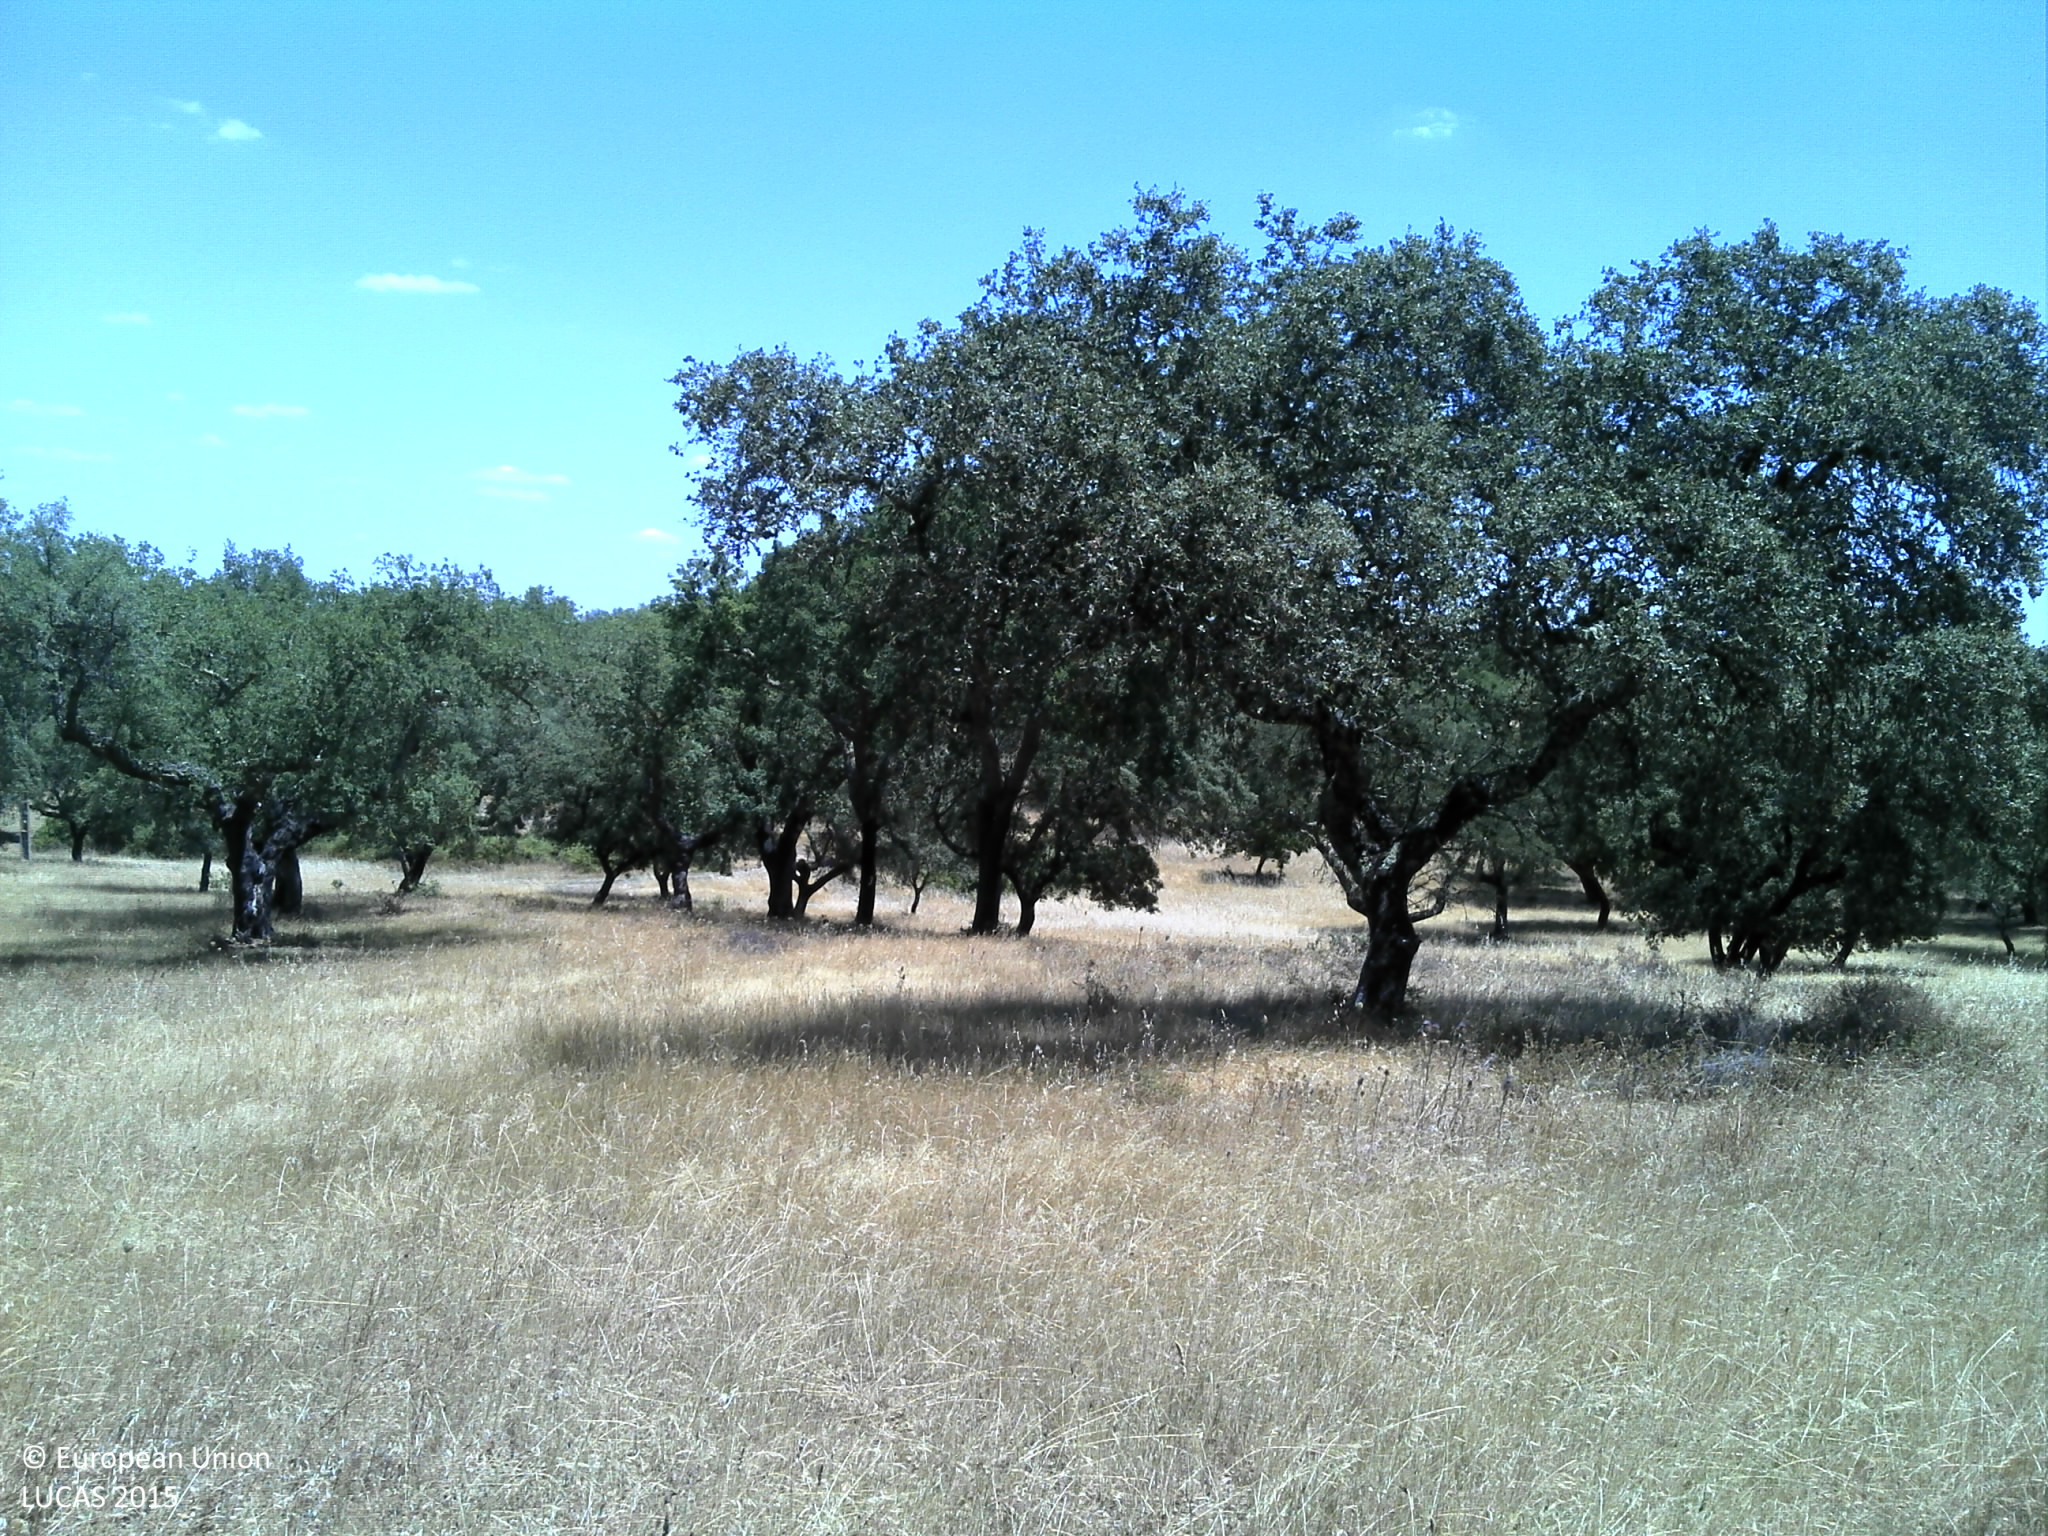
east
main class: Woodland
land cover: Broadleaved woodland
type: broadleaved evergreen forest
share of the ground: 25 - 50 %
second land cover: Grassland without tree/shrub cover
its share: 25 - 50 %
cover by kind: unconsolidated bare surface 45 %, herbaceous plants 30 %, broadleaved forest trees 25 %
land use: Forestry
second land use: Agriculture (excluding fallow land and kitchen gardens)
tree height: > 5 m
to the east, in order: Broadleaved woodland; Grassland without tree/shrub cover; Broadleaved woodland; Rivers and streams; Broadleaved woodland; Fences; Grass margins; Tracks; Grass margins; Ditches and canals; Fences; Broadleaved woodland
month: June
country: PT
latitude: 38.3974
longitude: -8.1211
